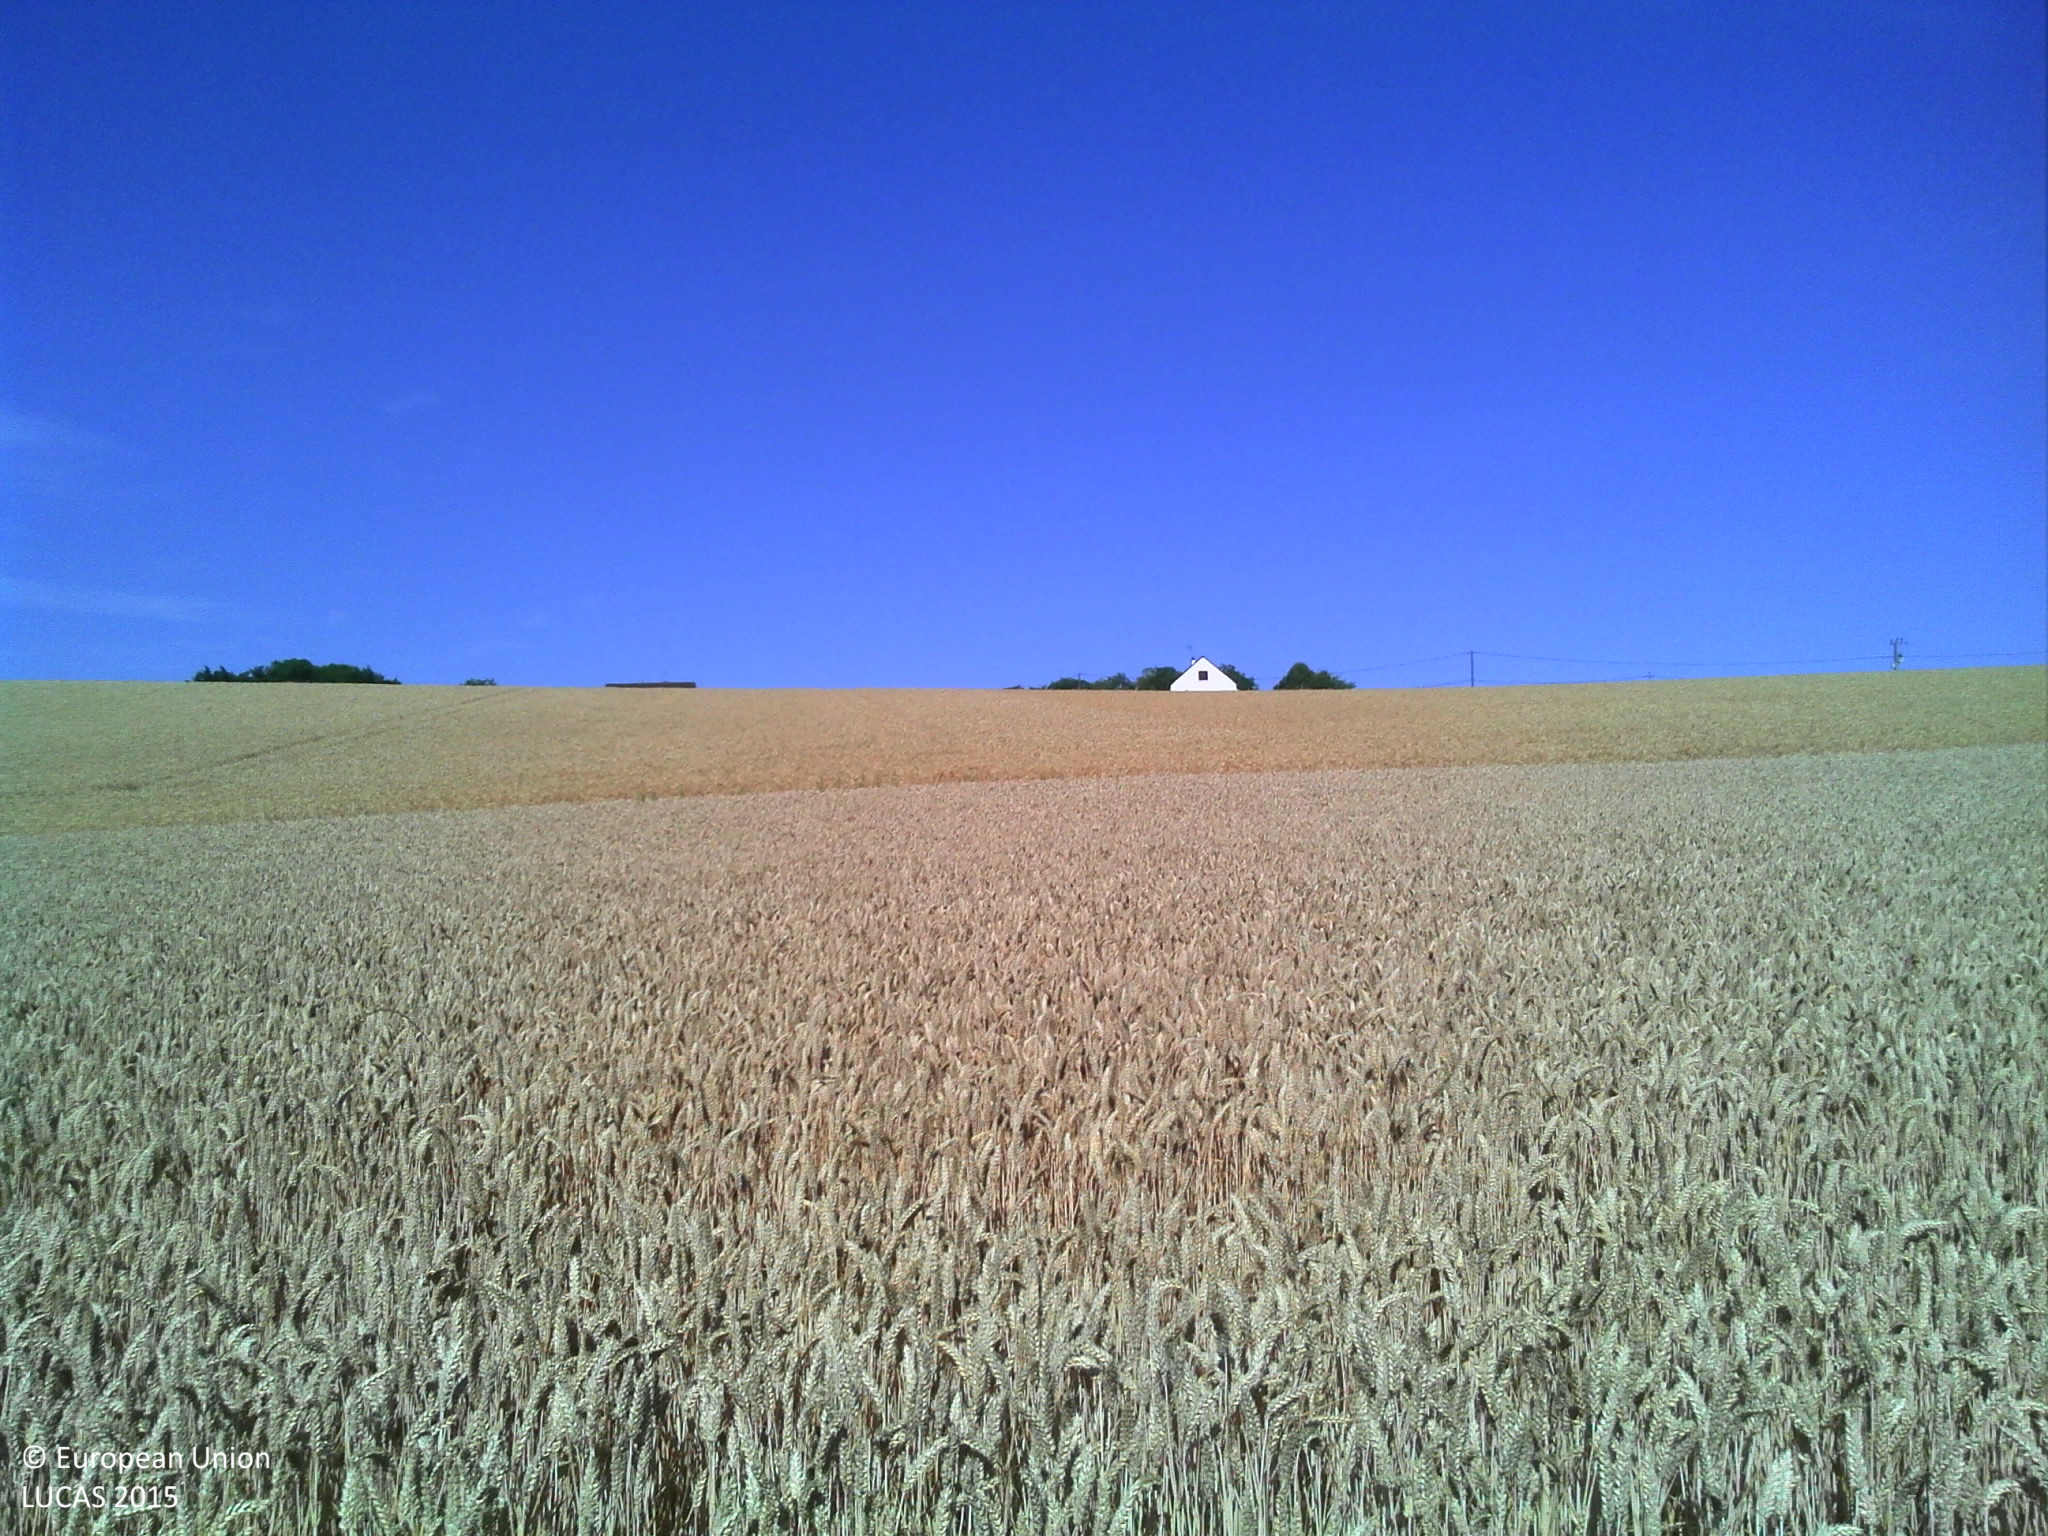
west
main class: Cropland
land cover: Common wheat
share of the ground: > 75 %
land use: Agriculture (excluding fallow land and kitchen gardens)
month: July
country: FR
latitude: 47.9316
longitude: 3.0465
